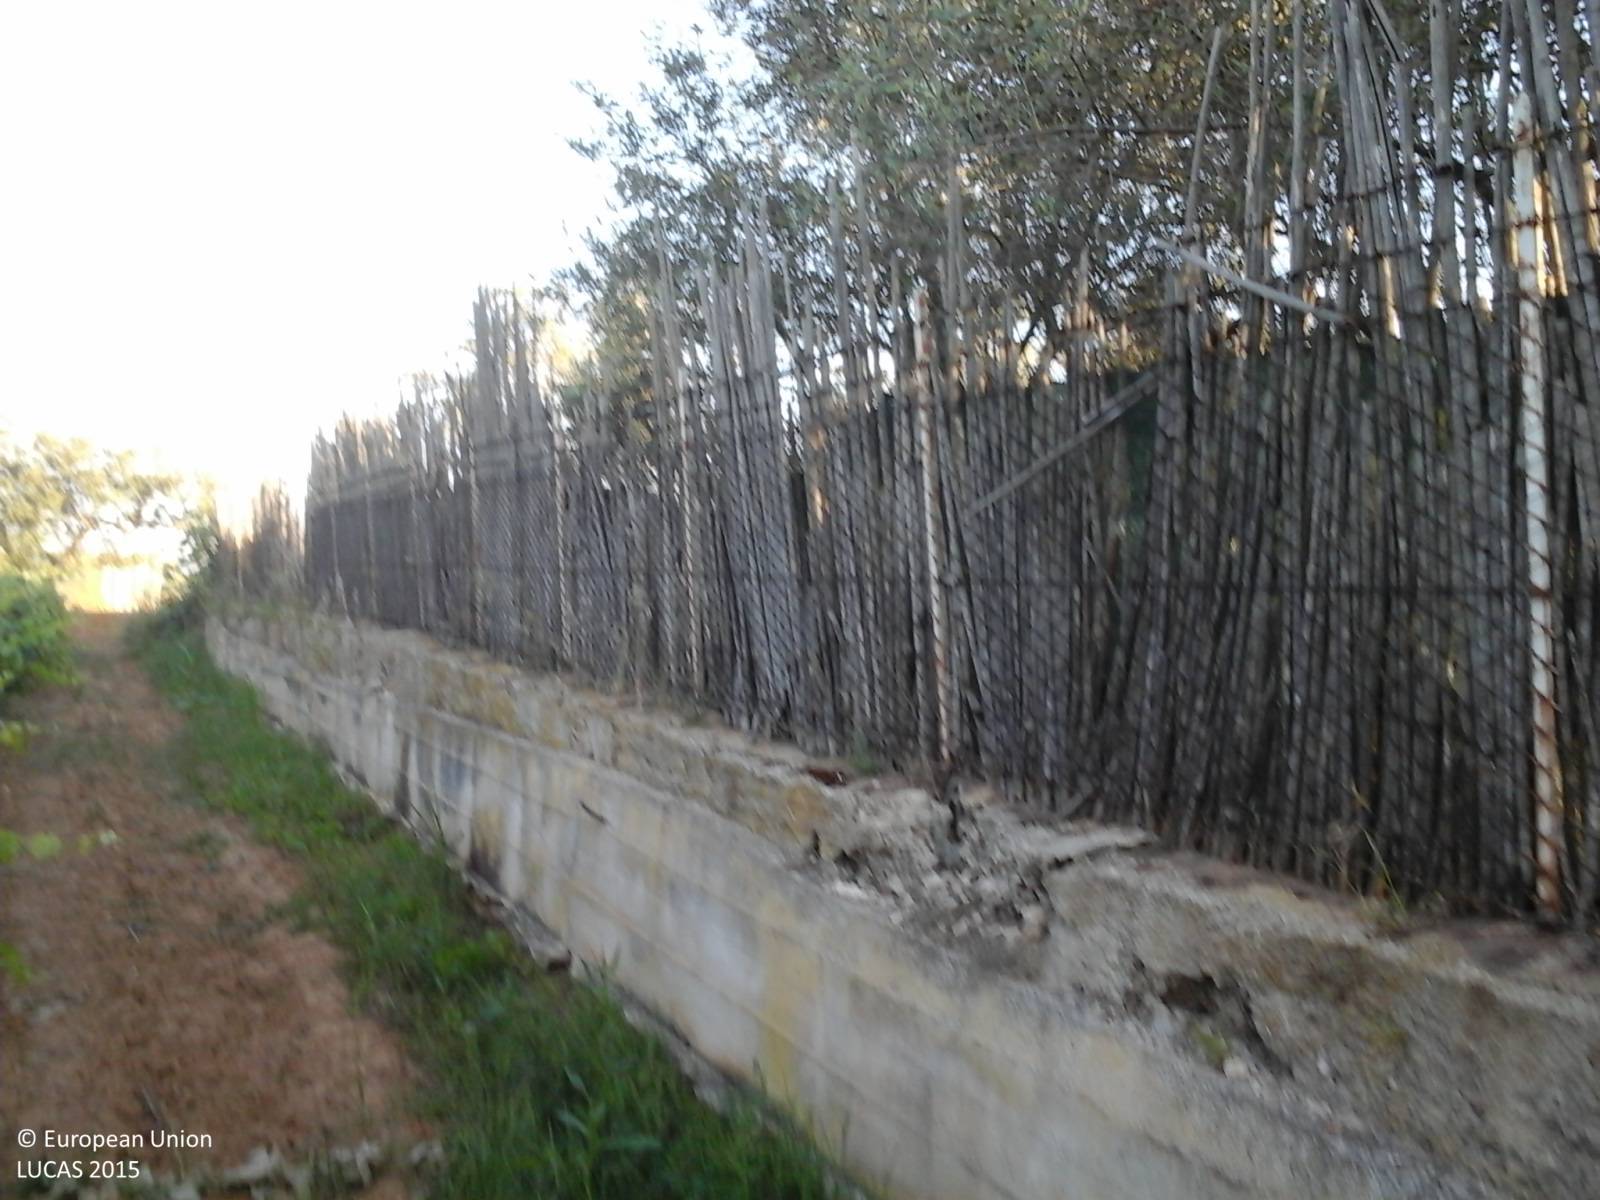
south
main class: Cropland
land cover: Vineyards
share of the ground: 25 - 50 %
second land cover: Olive groves
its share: > 75 %
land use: Agriculture (excluding fallow land and kitchen gardens)
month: June
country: IT
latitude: 38.0069
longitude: 13.0645
